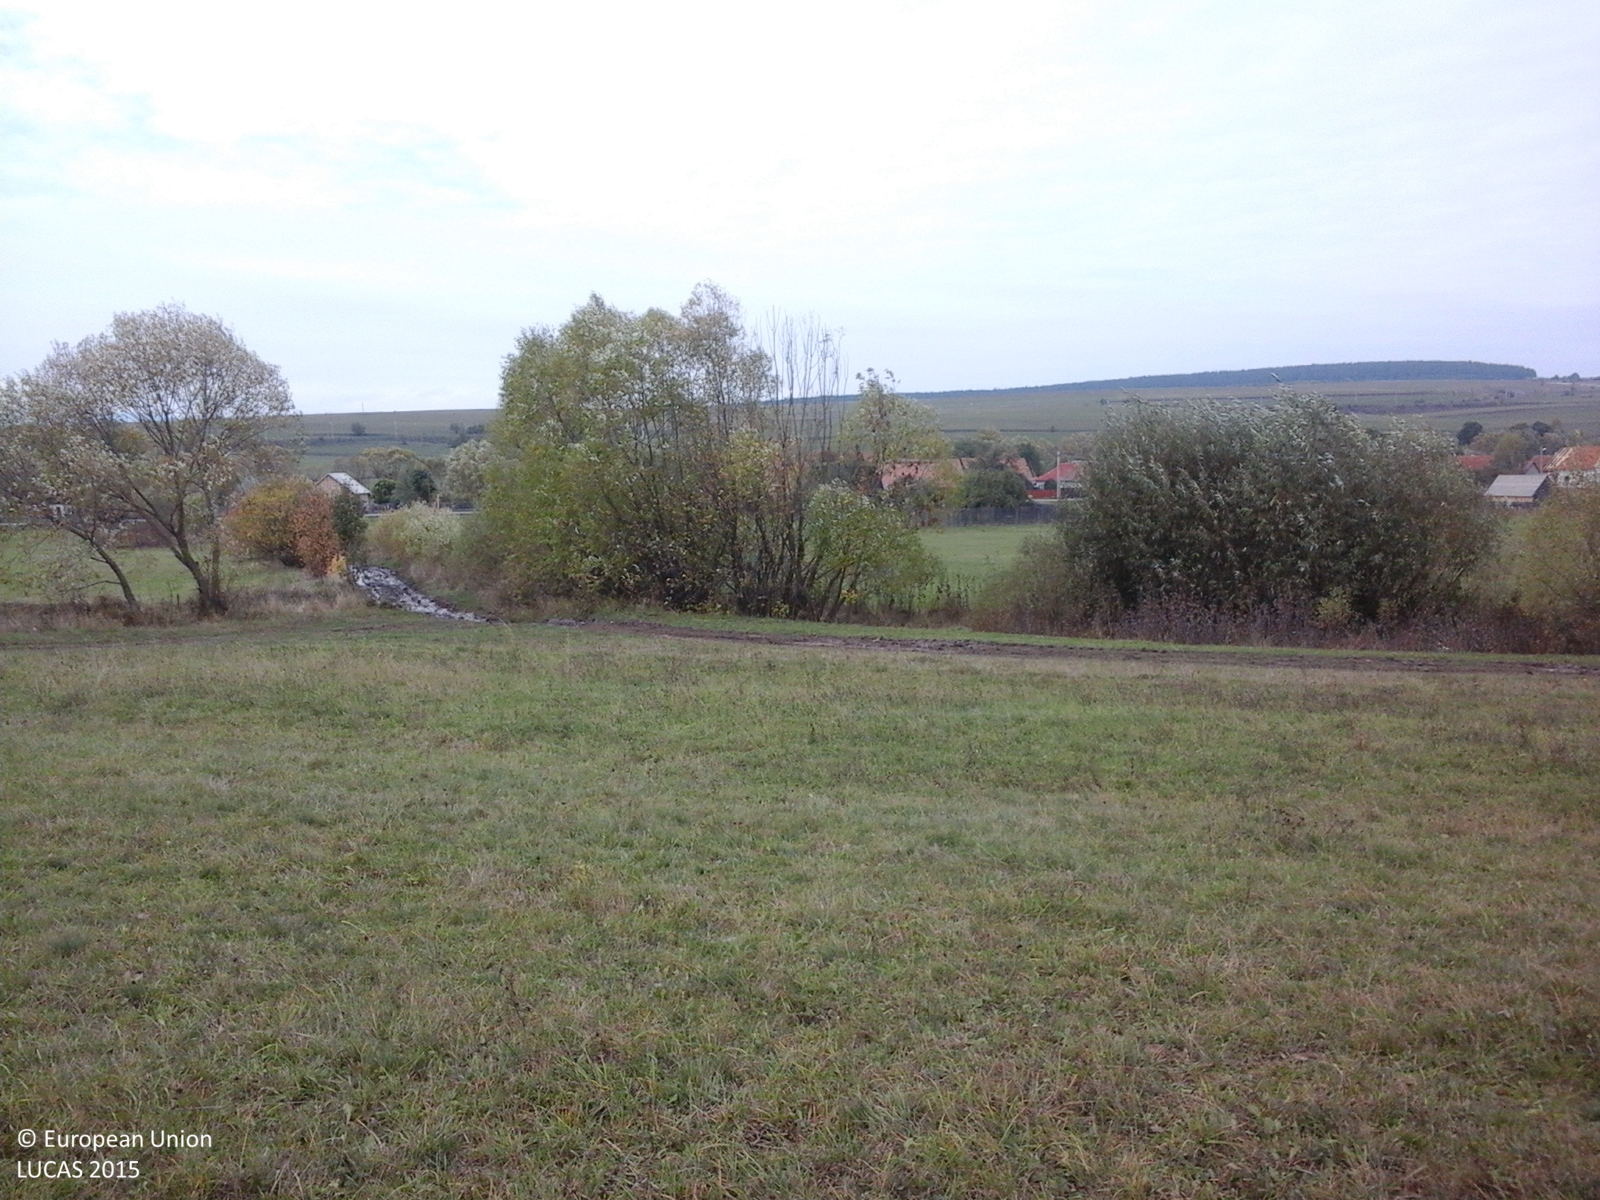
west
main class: Grassland
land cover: Grassland without tree/shrub cover
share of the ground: > 75 %
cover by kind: herbaceous plants 100 %
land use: Agriculture (excluding fallow land and kitchen gardens)
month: October
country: RO
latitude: 46.4820
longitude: 25.8392
